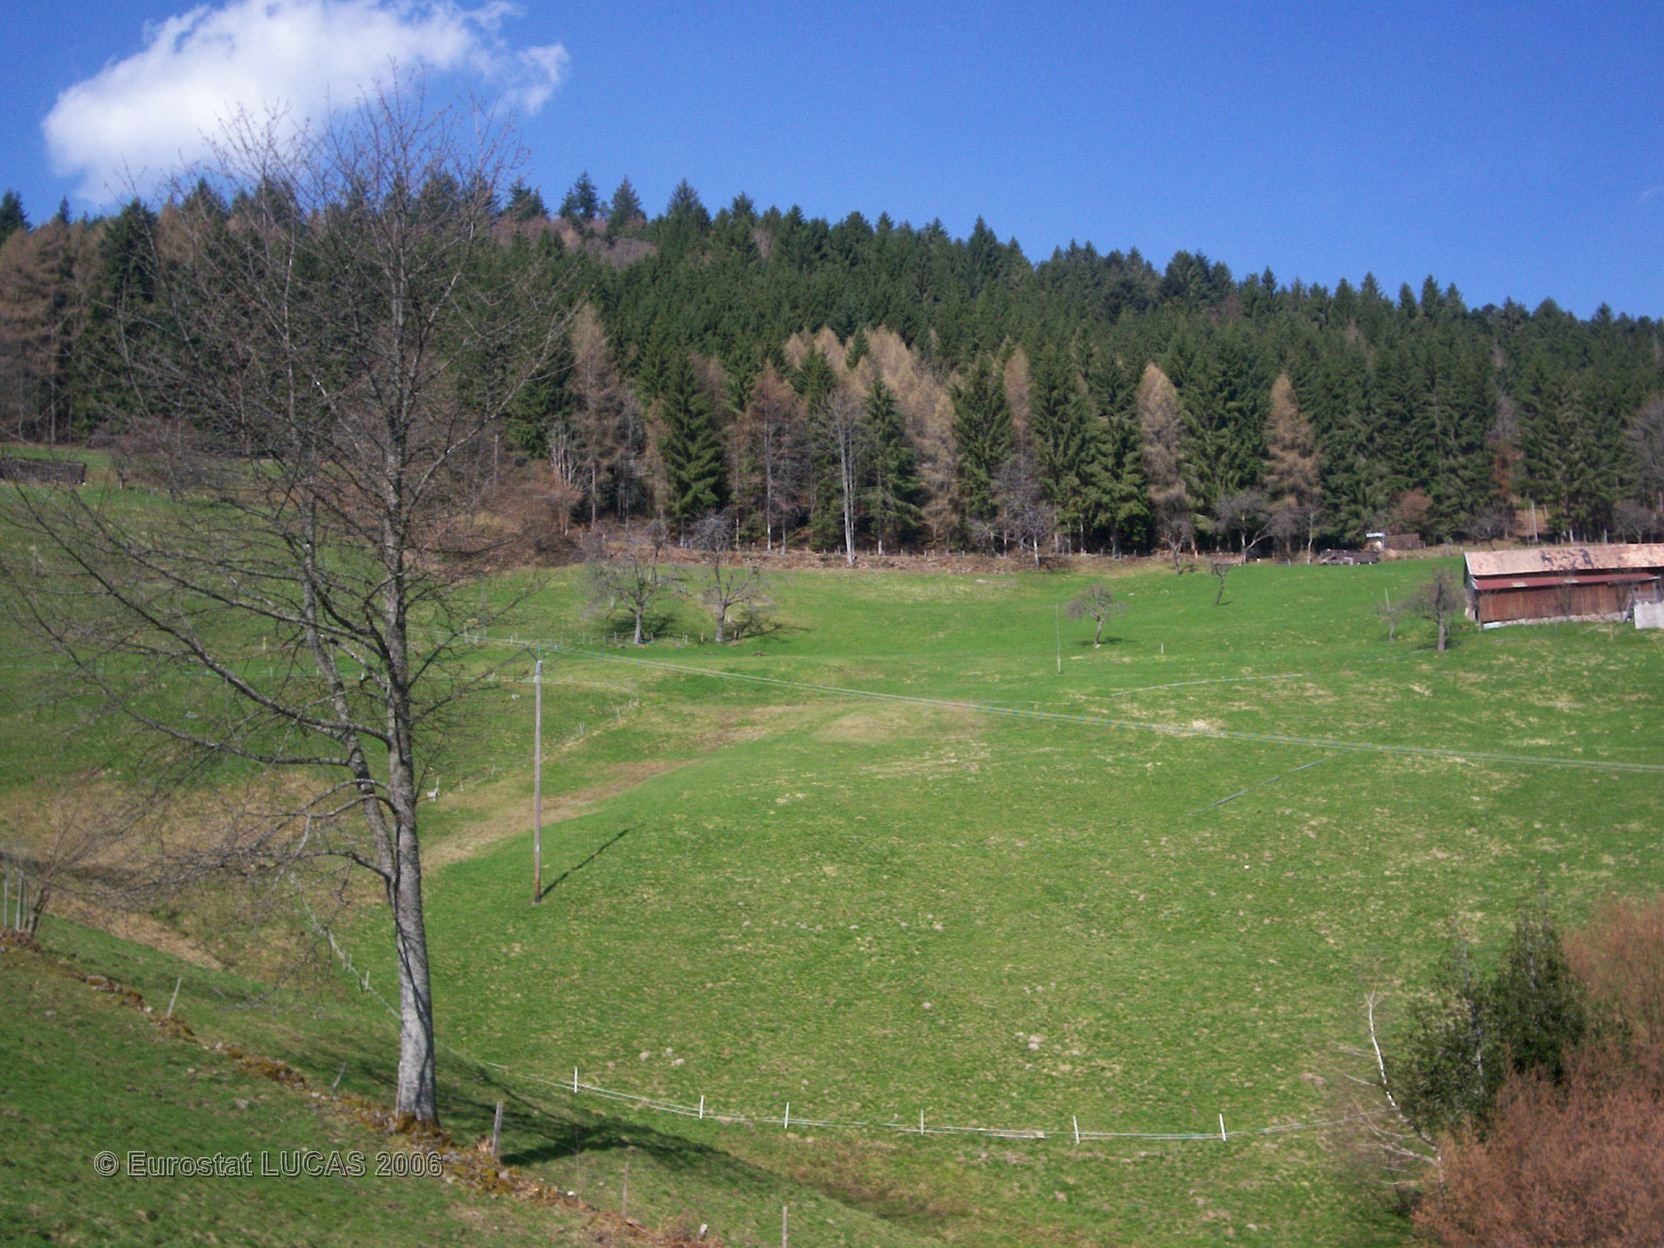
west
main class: Grassland
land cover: Grassland without tree/shrub cover
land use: Agriculture (excluding fallow land and kitchen gardens)
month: April
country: FR
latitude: 48.0411
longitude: 7.0905
